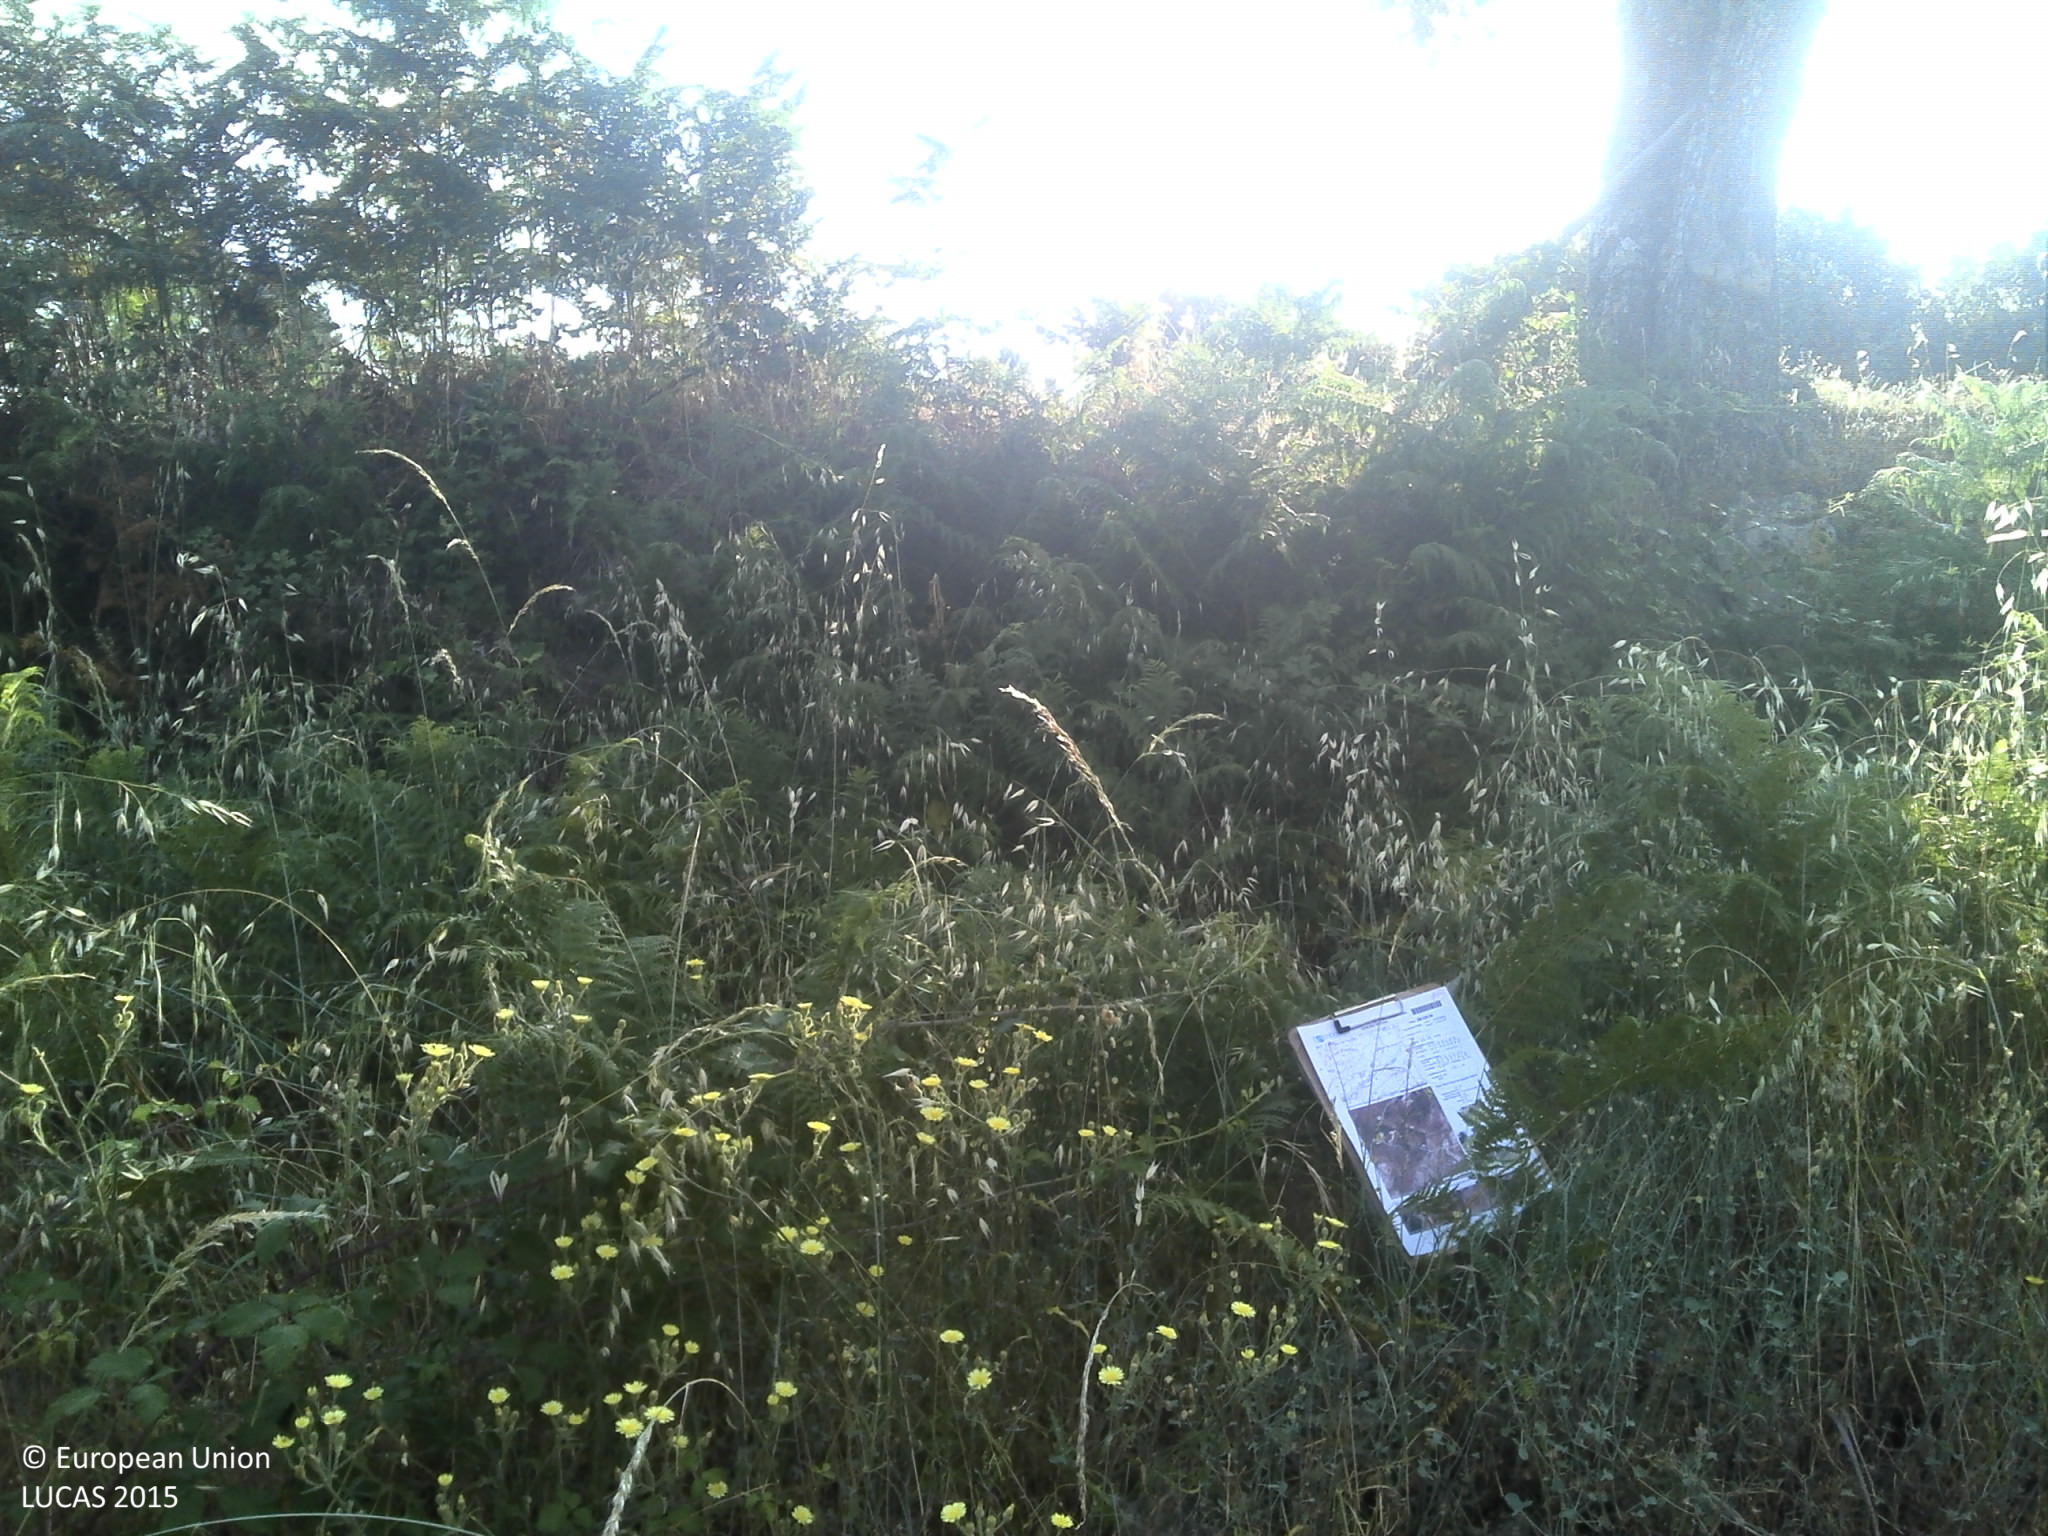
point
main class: Grassland
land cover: Grassland without tree/shrub cover
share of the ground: 50 - 75 %
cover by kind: herbaceous plants 55 %, unconsolidated bare surface 45 %
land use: Agriculture (excluding fallow land and kitchen gardens)
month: June
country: PT
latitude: 40.3568
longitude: -7.2102
